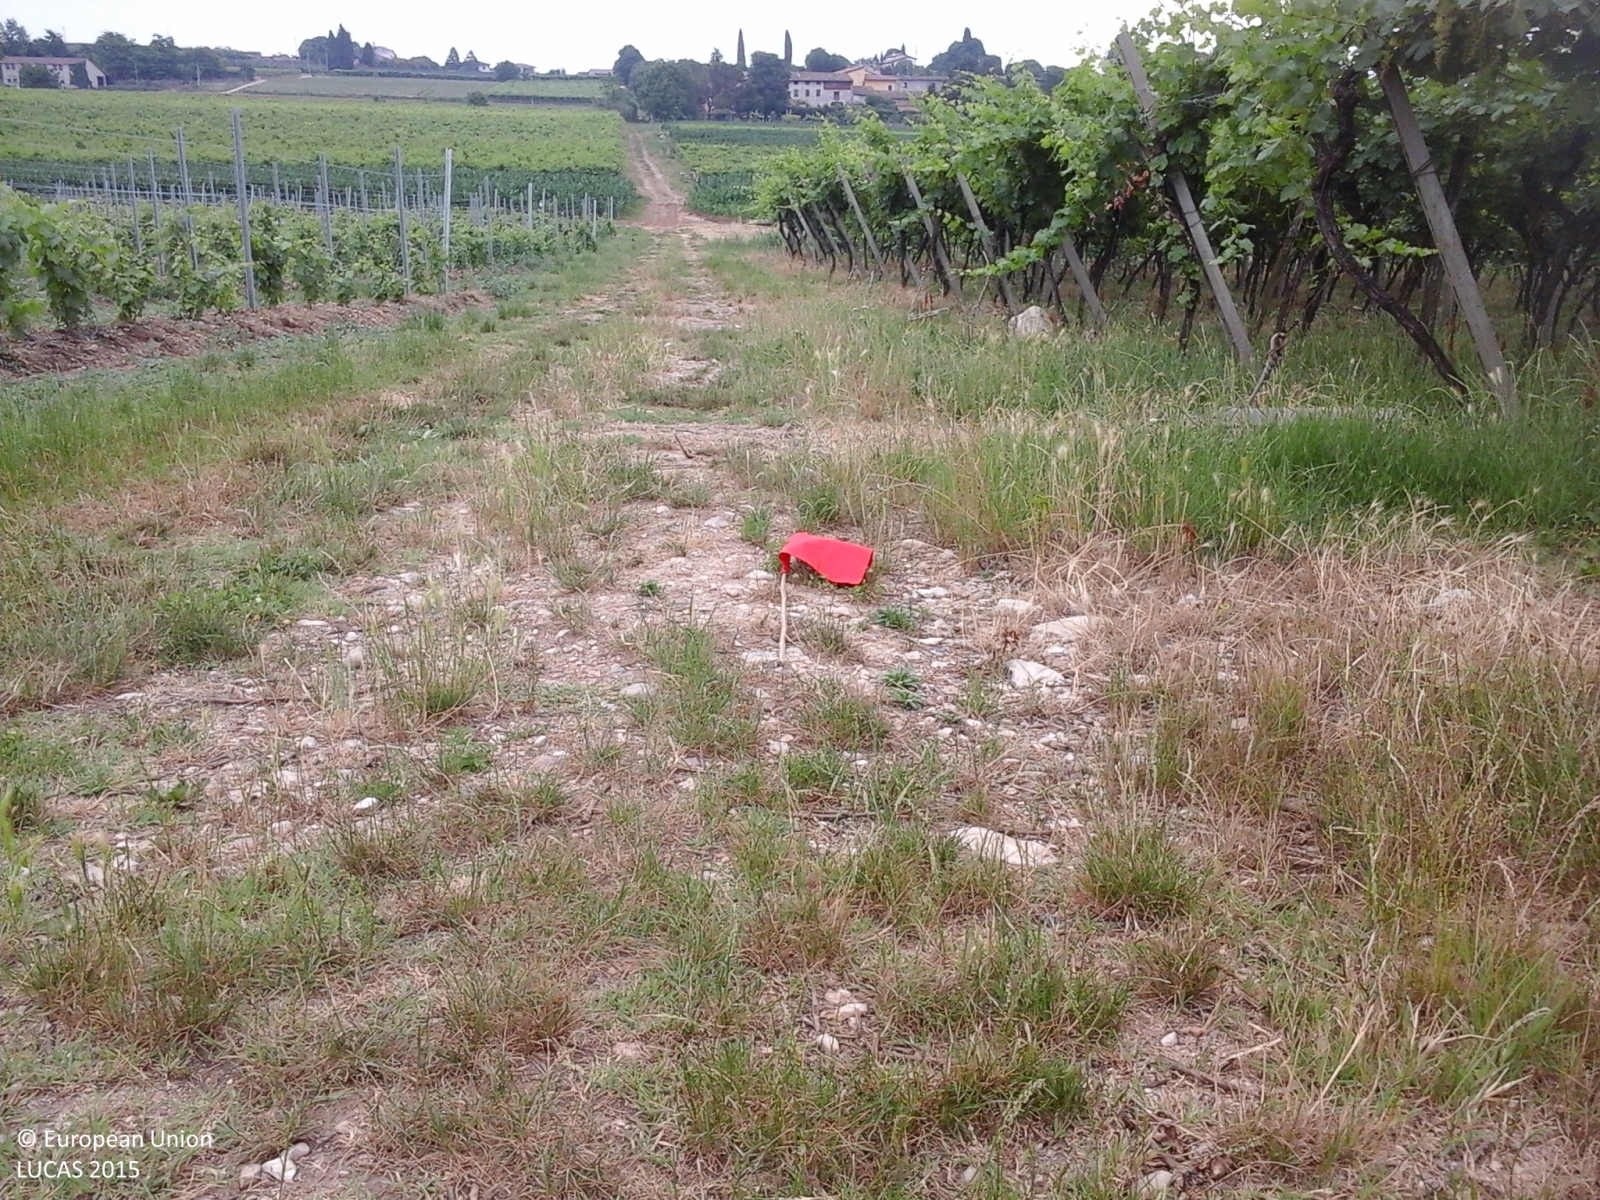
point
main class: Cropland
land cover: Vineyards
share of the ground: > 75 %
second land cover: Grassland without tree/shrub cover
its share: > 75 %
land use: Agriculture (excluding fallow land and kitchen gardens)
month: June
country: IT
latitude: 45.4293
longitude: 10.8039
